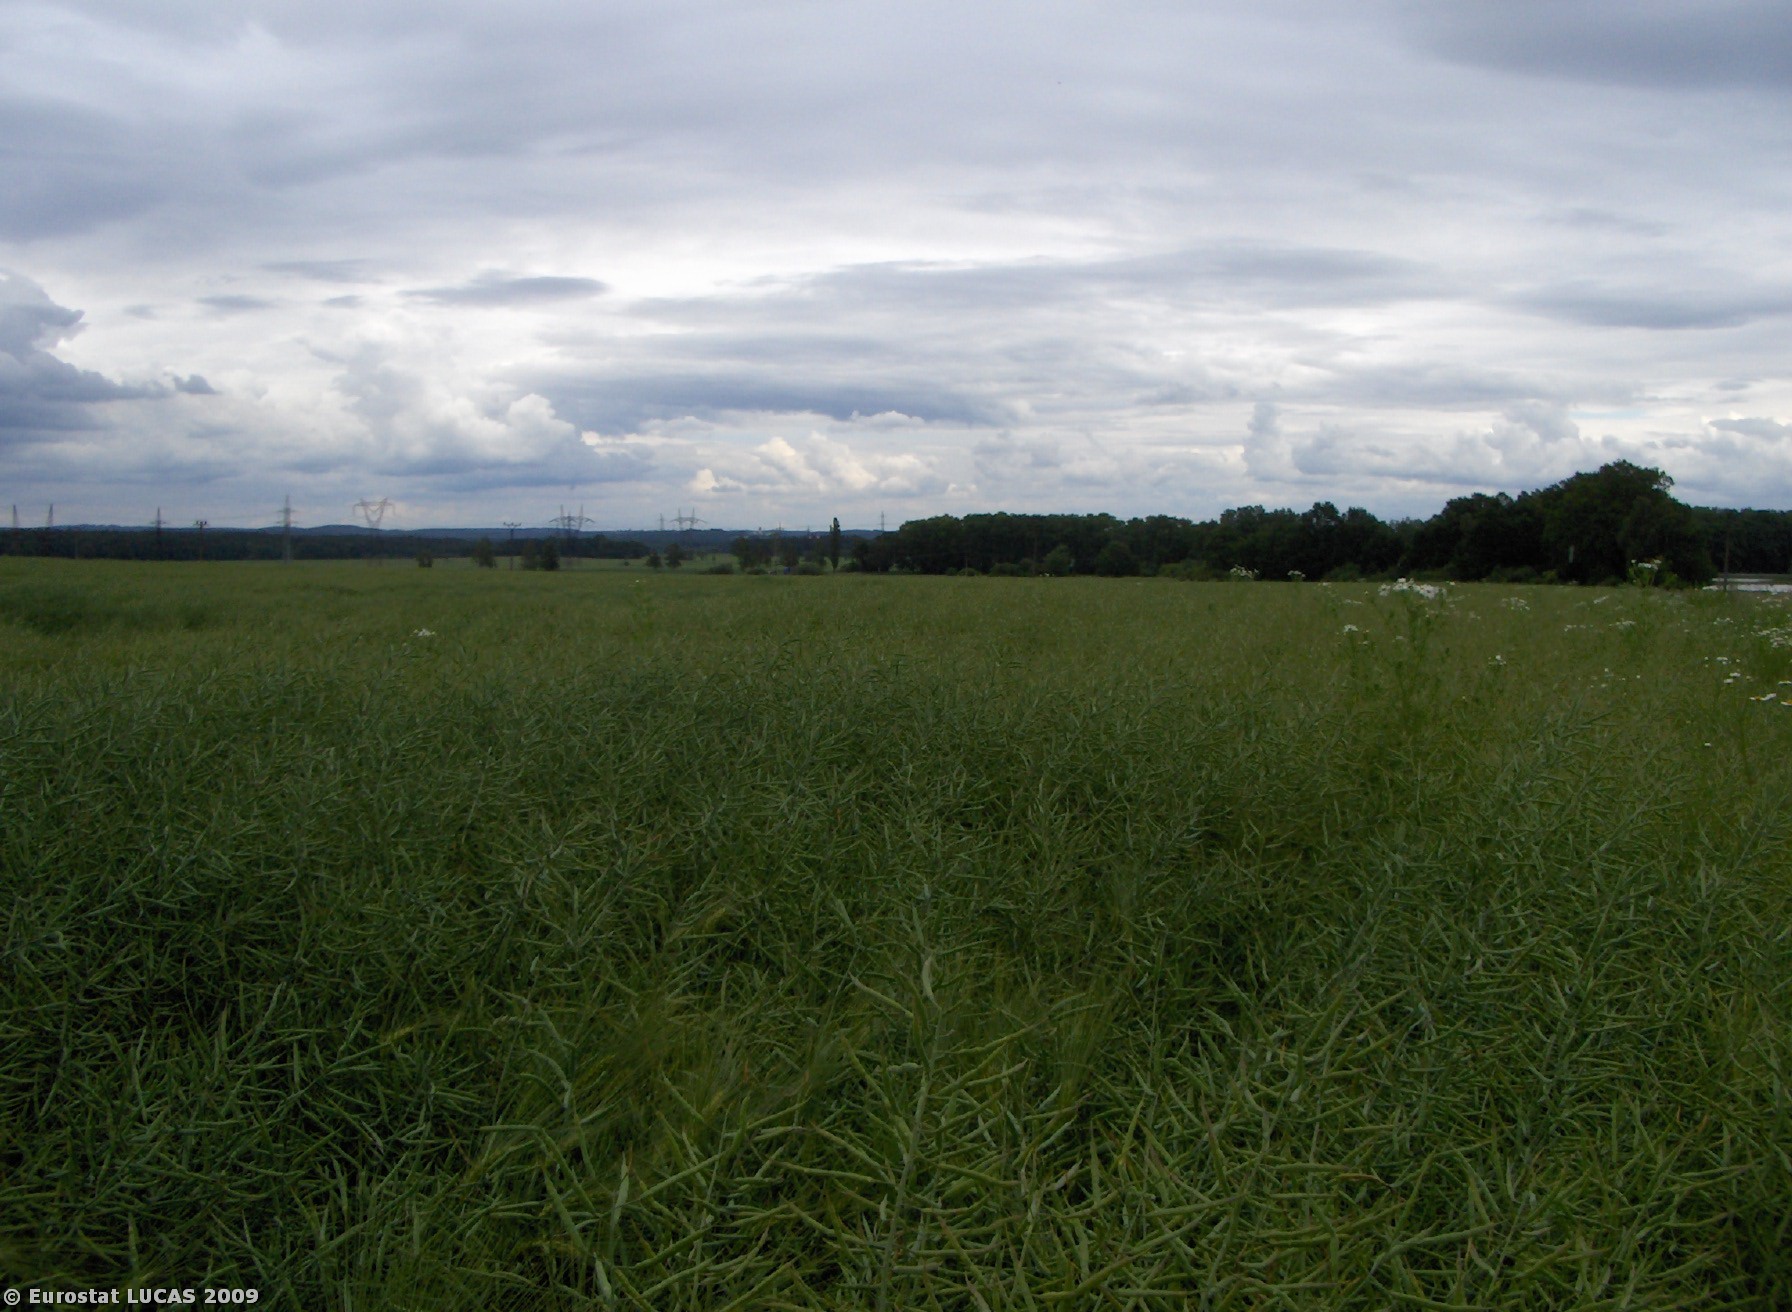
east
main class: Cropland
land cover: Rape and turnip rape
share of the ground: > 75 %
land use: Agriculture (excluding fallow land and kitchen gardens)
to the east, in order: Rape and turnip rape; Electric lines; Rape and turnip rape
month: June
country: CZ
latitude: 49.0391
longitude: 14.3373
